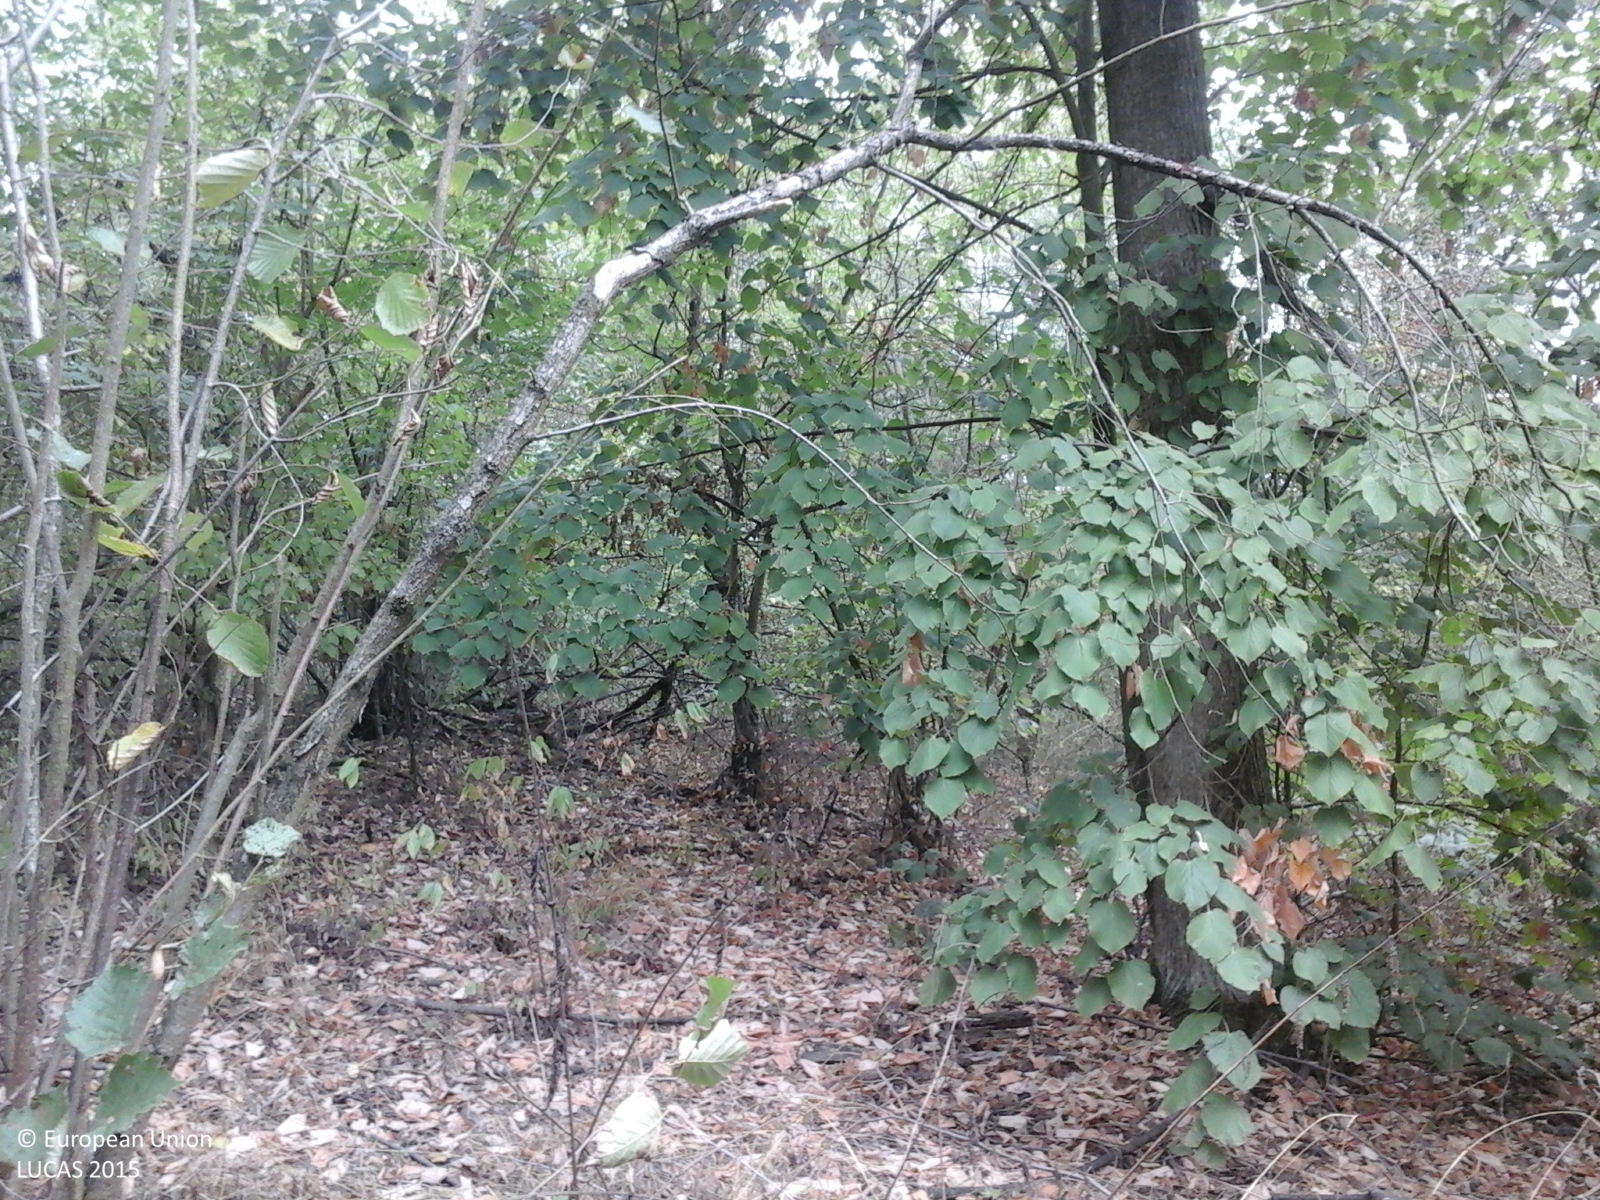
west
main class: Woodland
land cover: Broadleaved woodland
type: mesophytic deciduous forest
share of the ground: > 75 %
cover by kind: broadleaved forest trees 100 %
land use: Forestry
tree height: > 5 m
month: September
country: RO
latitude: 47.7279
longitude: 22.3352
